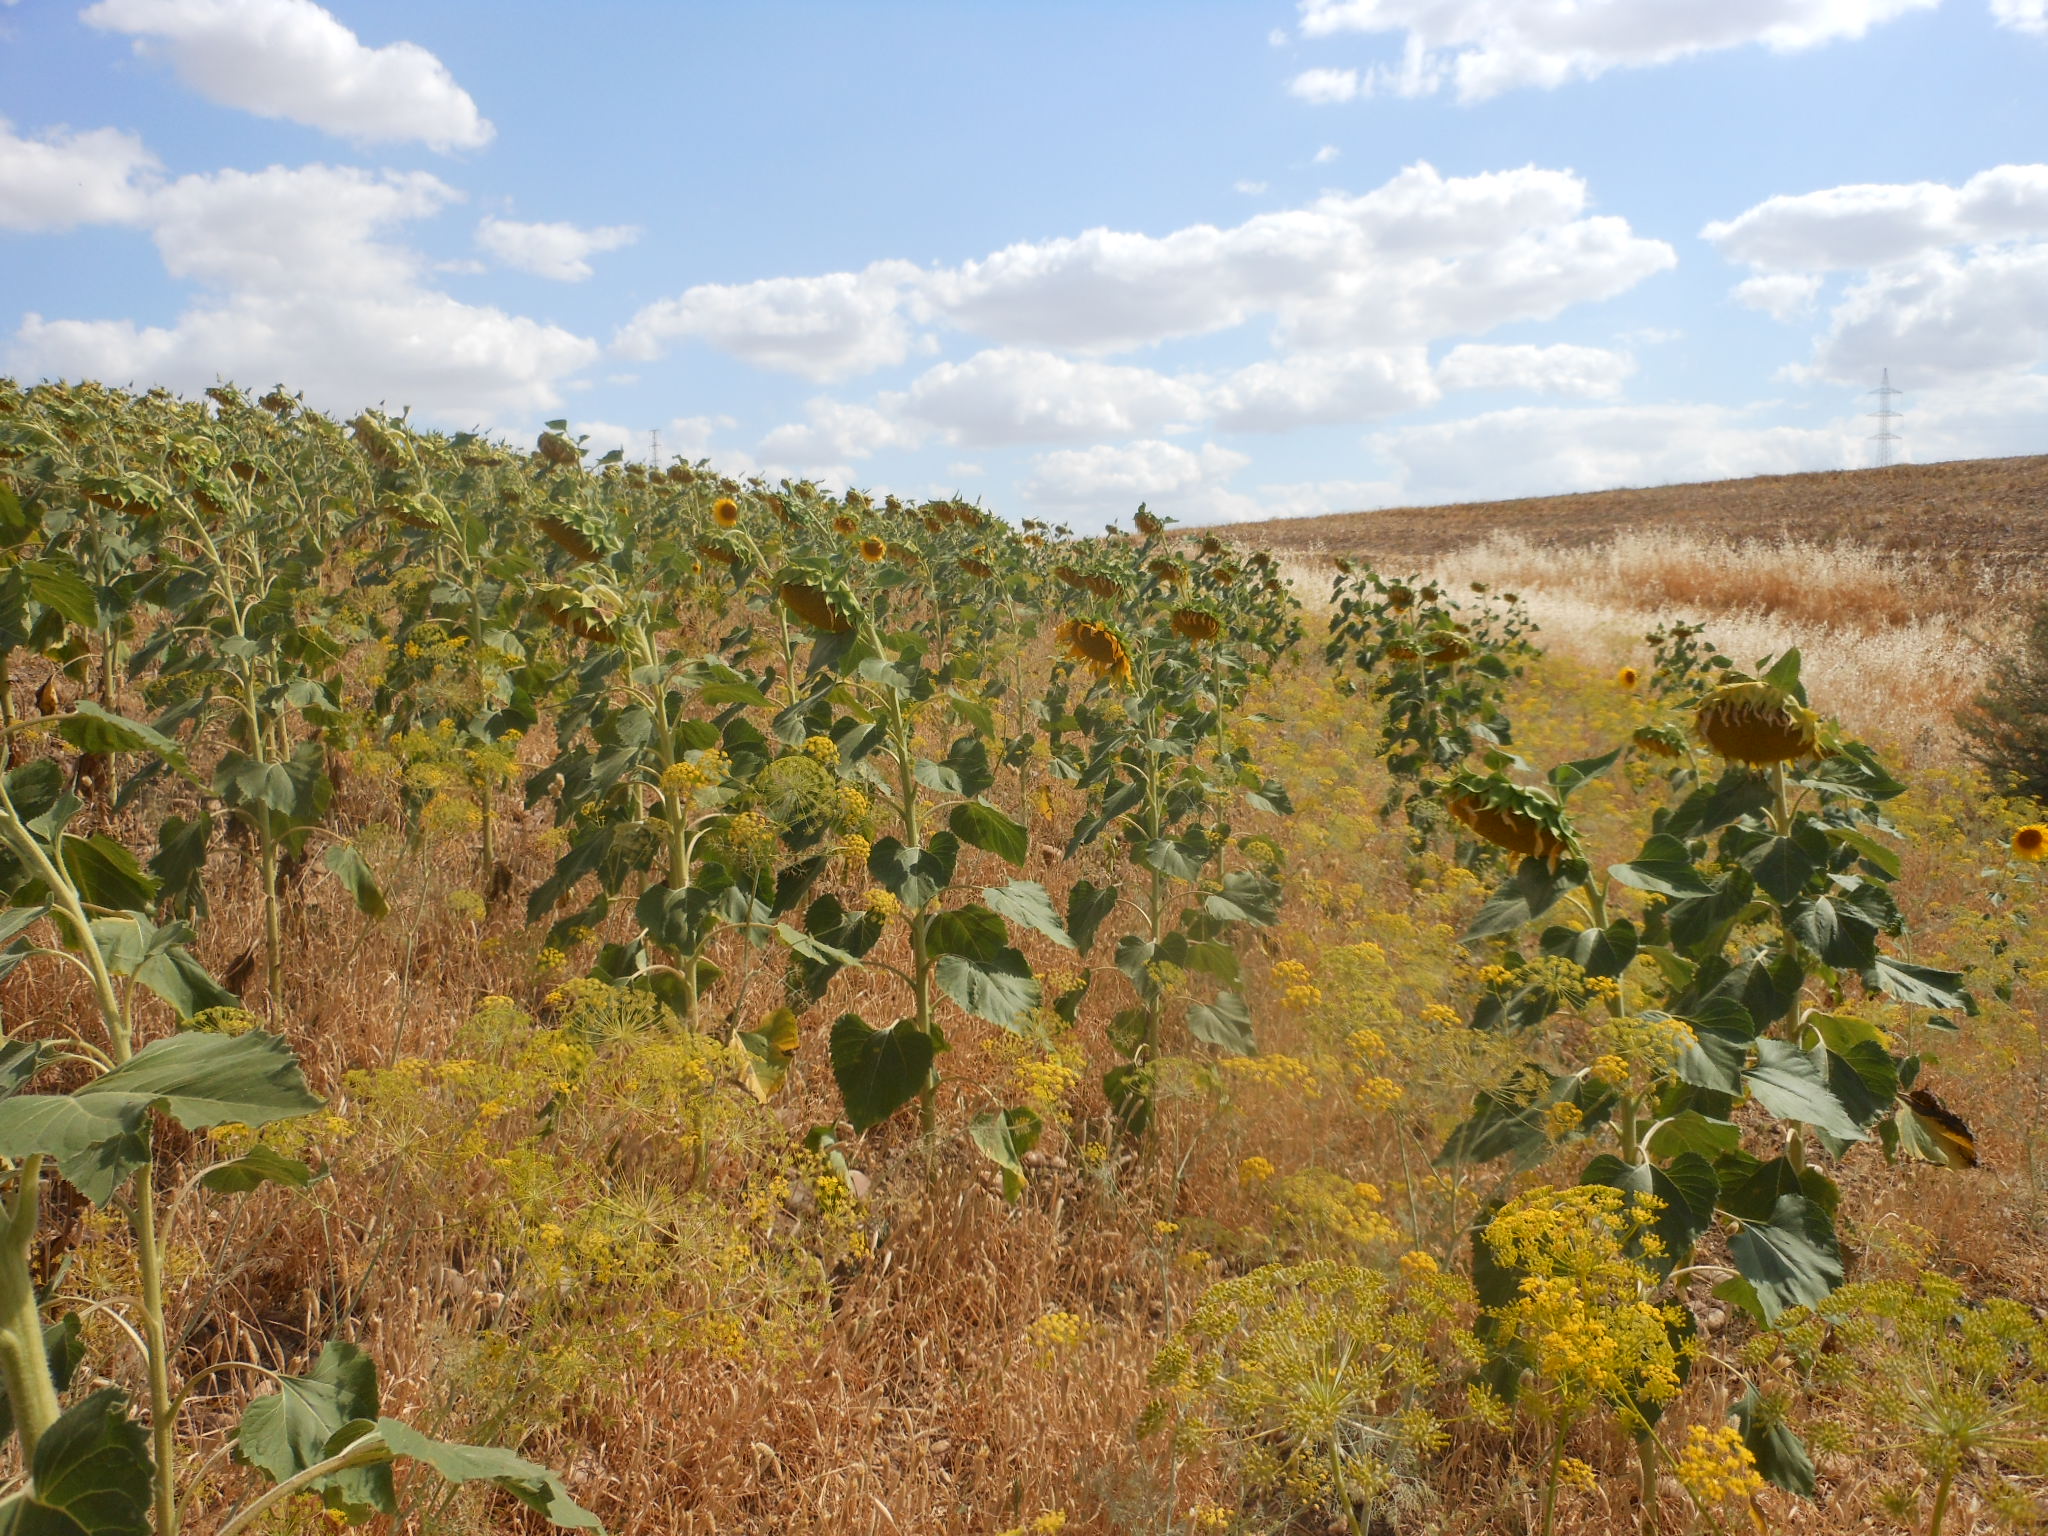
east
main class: Cropland
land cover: Sunflower
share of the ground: > 75 %
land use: Agriculture (excluding fallow land and kitchen gardens)
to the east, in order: Sunflower
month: June
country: ES
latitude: 37.5927
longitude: -5.1569
